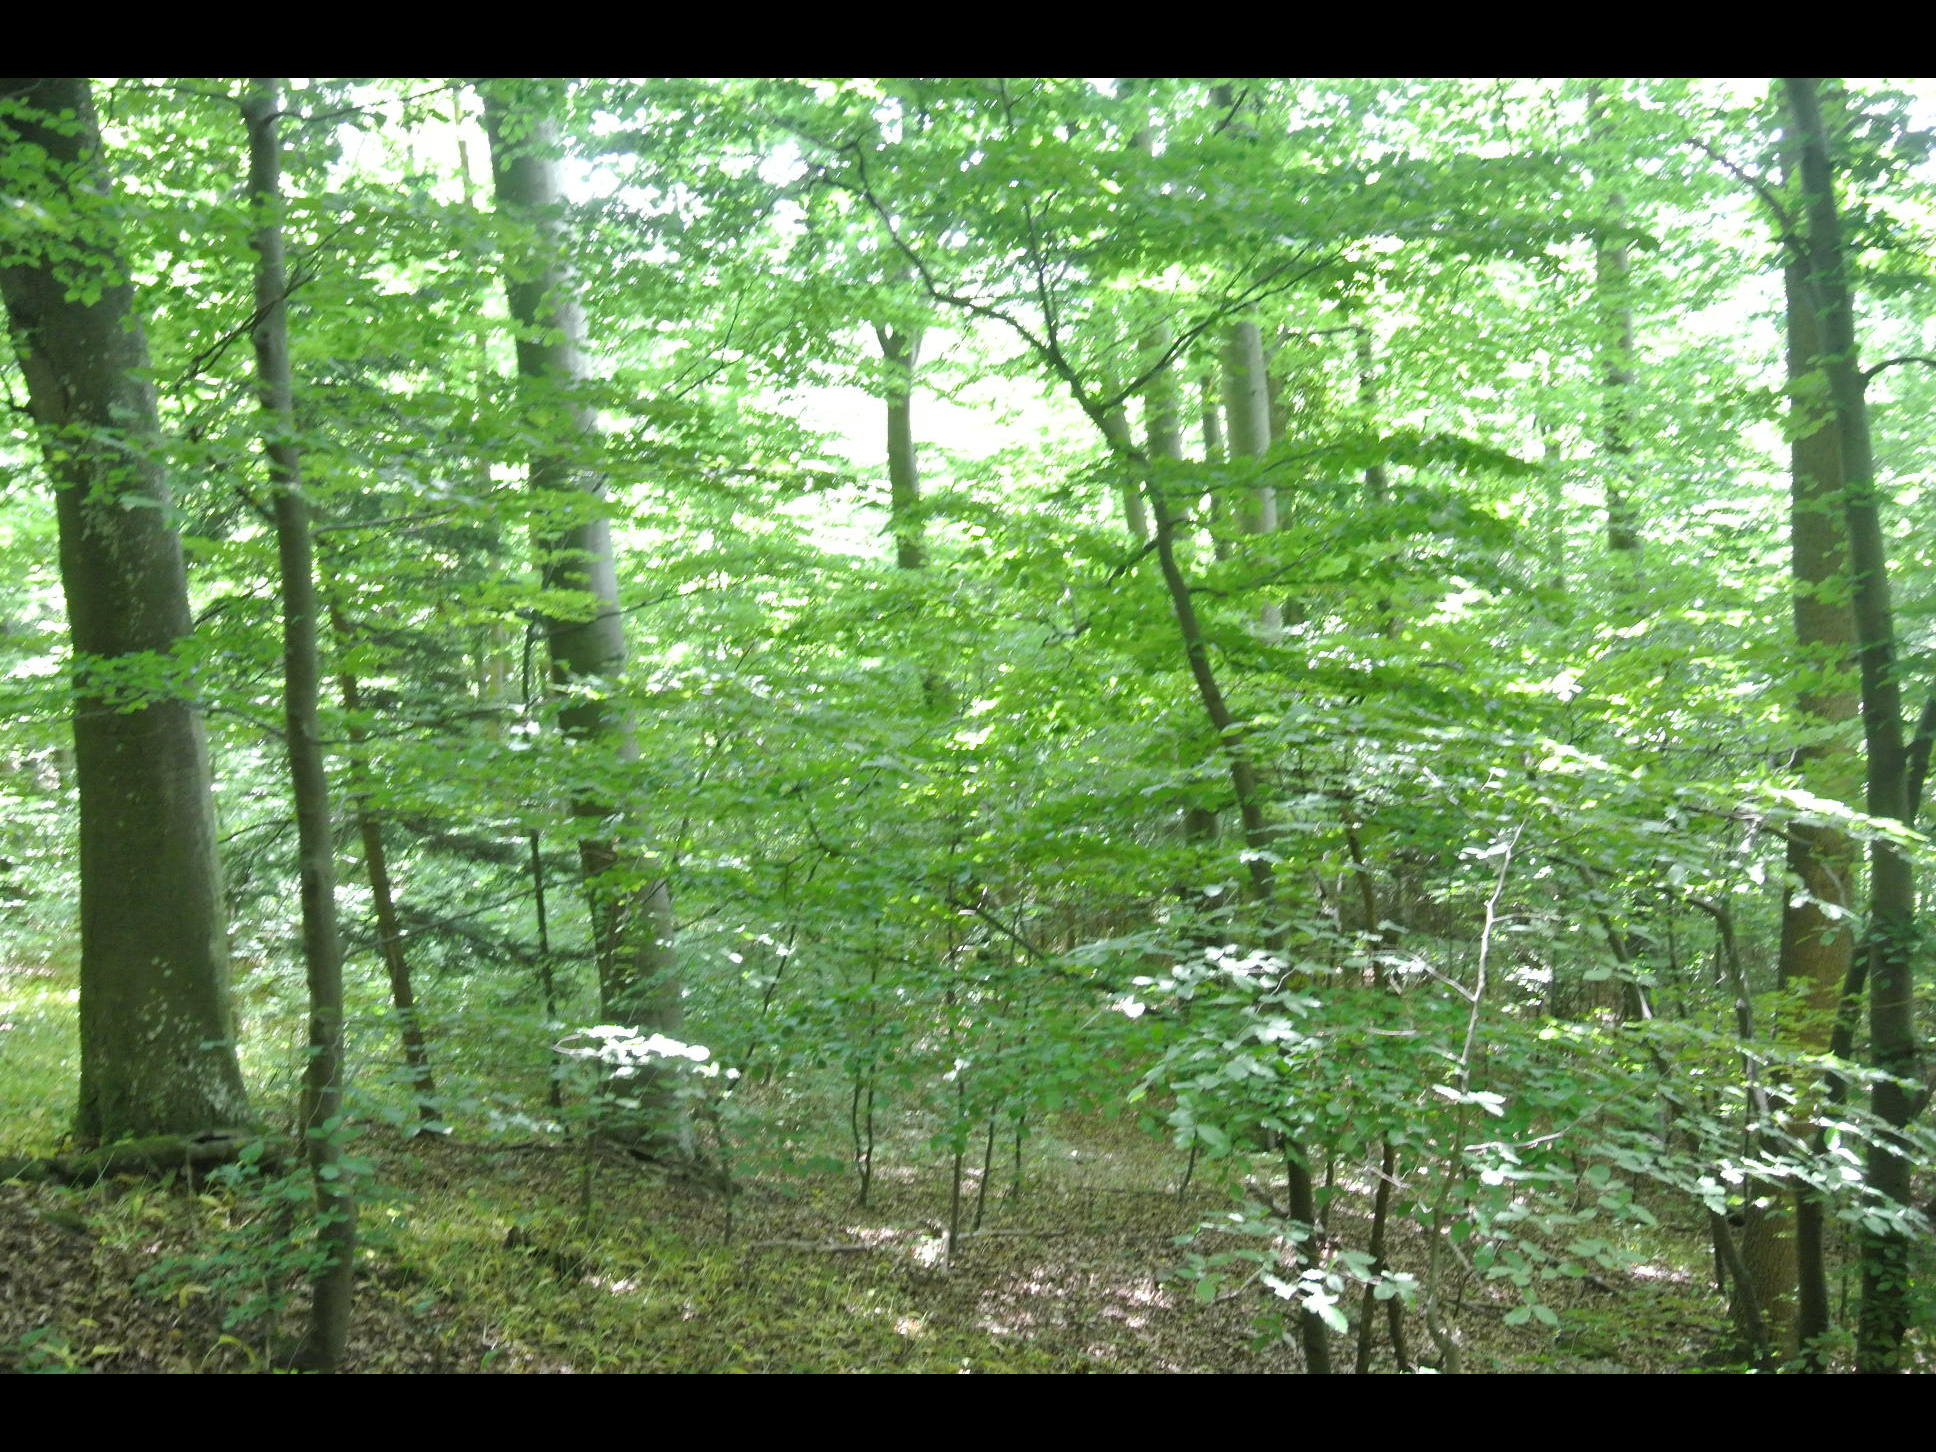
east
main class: Woodland
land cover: Broadleaved woodland
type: beech forest
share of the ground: > 75 %
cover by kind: broadleaved forest trees 100 %
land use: Forestry
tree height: > 5 m
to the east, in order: Broadleaved woodland; Tracks; Pine dominated coniferous woodland; Tracks; Pine dominated coniferous woodland; Spruce dominated mixed woodland
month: June
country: AT
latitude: 48.0033
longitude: 16.0484
